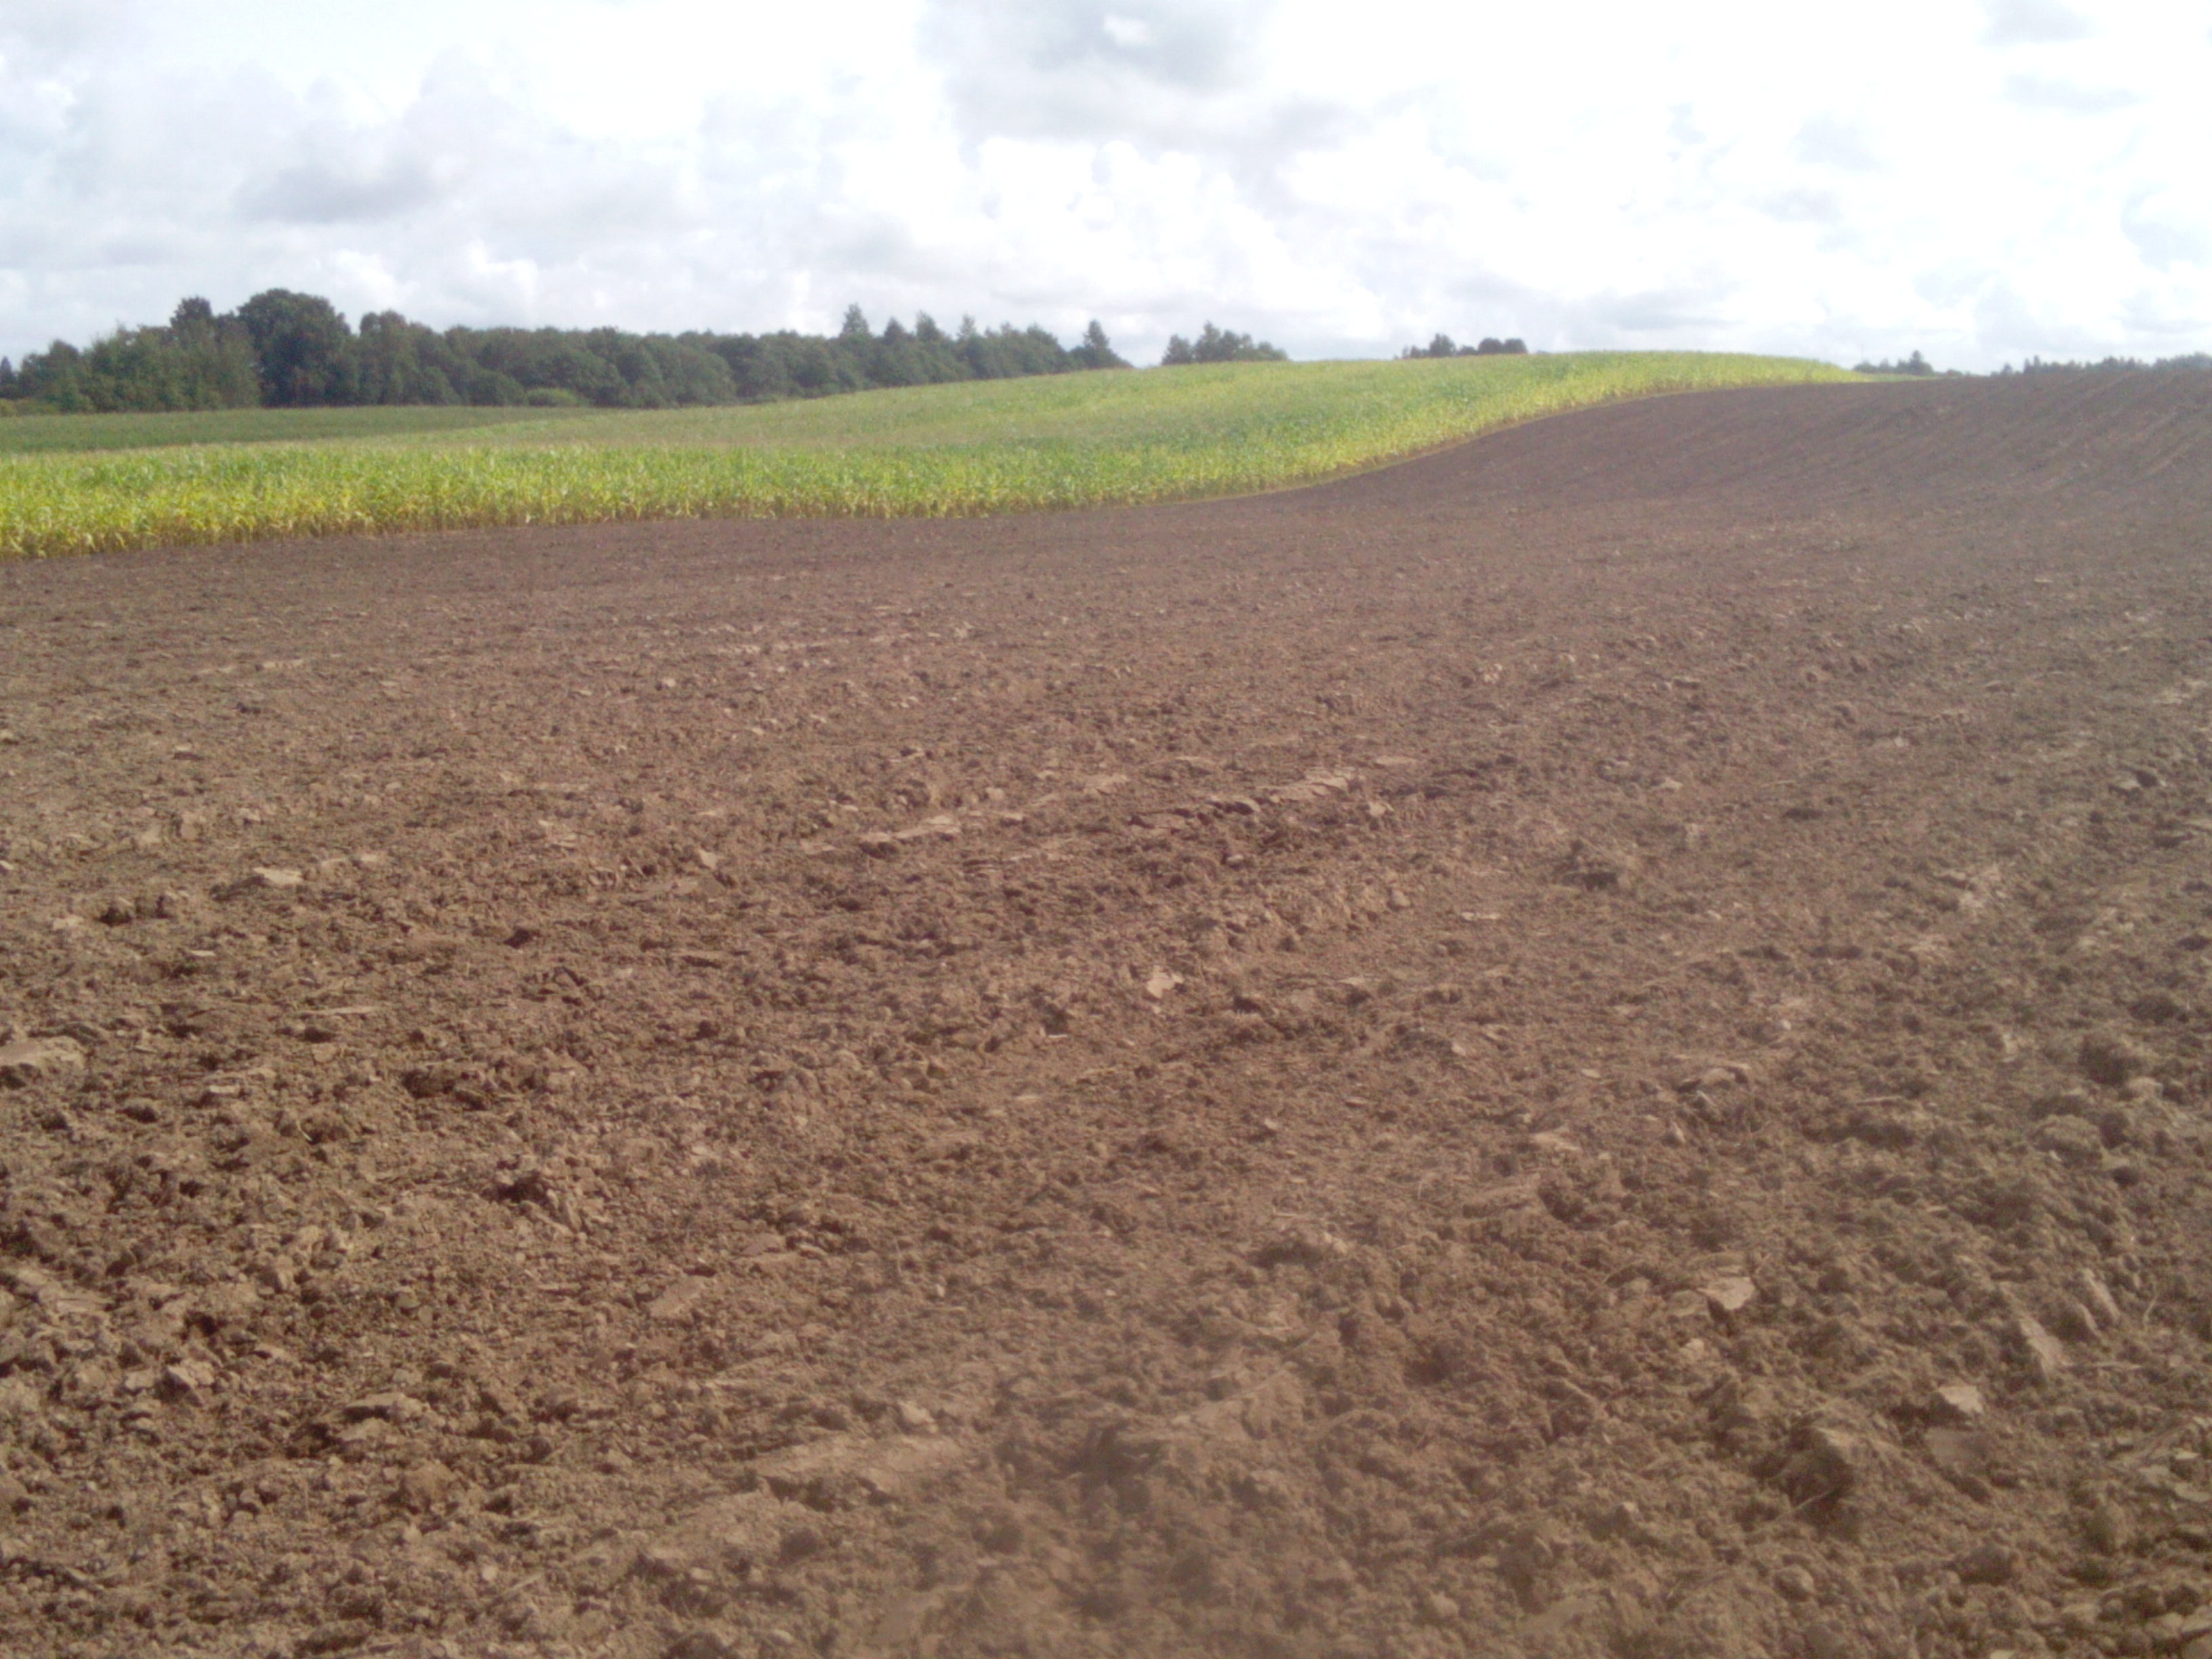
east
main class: Cropland
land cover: Common wheat
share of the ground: < 10 %
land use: Agriculture (excluding fallow land and kitchen gardens)
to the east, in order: Common wheat; Maize
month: September
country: LT
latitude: 55.9027
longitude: 22.4871
